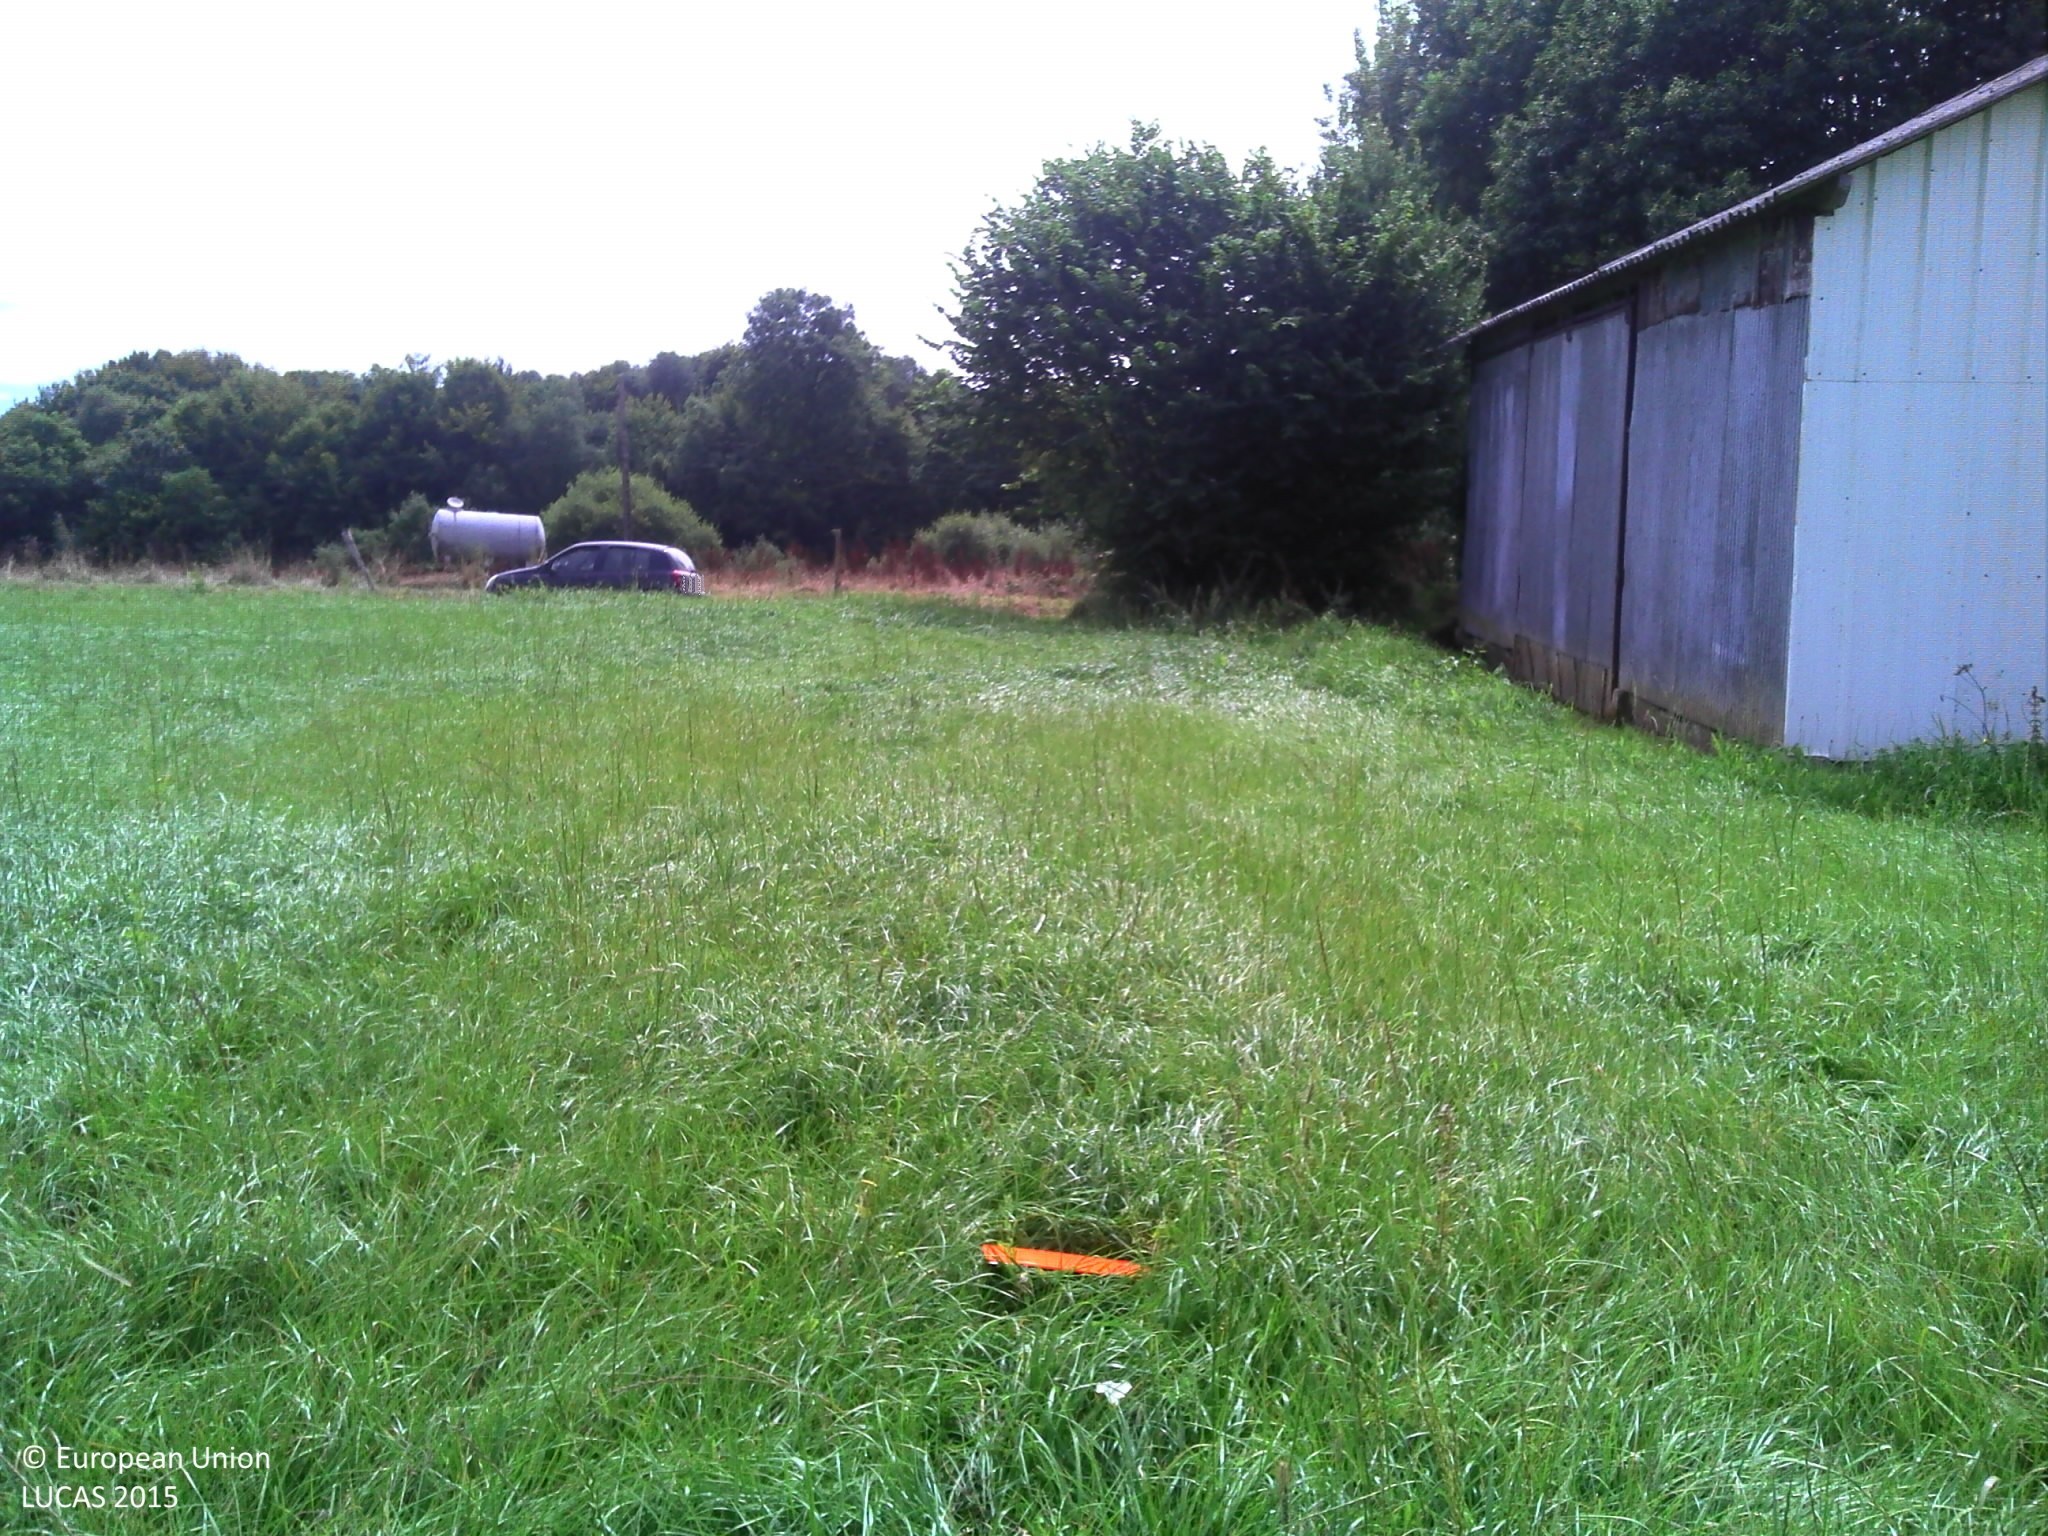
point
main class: Cropland
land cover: Temporary grasslands
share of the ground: > 75 %
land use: Agriculture (excluding fallow land and kitchen gardens)
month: August
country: FR
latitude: 48.5022
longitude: -3.4913
